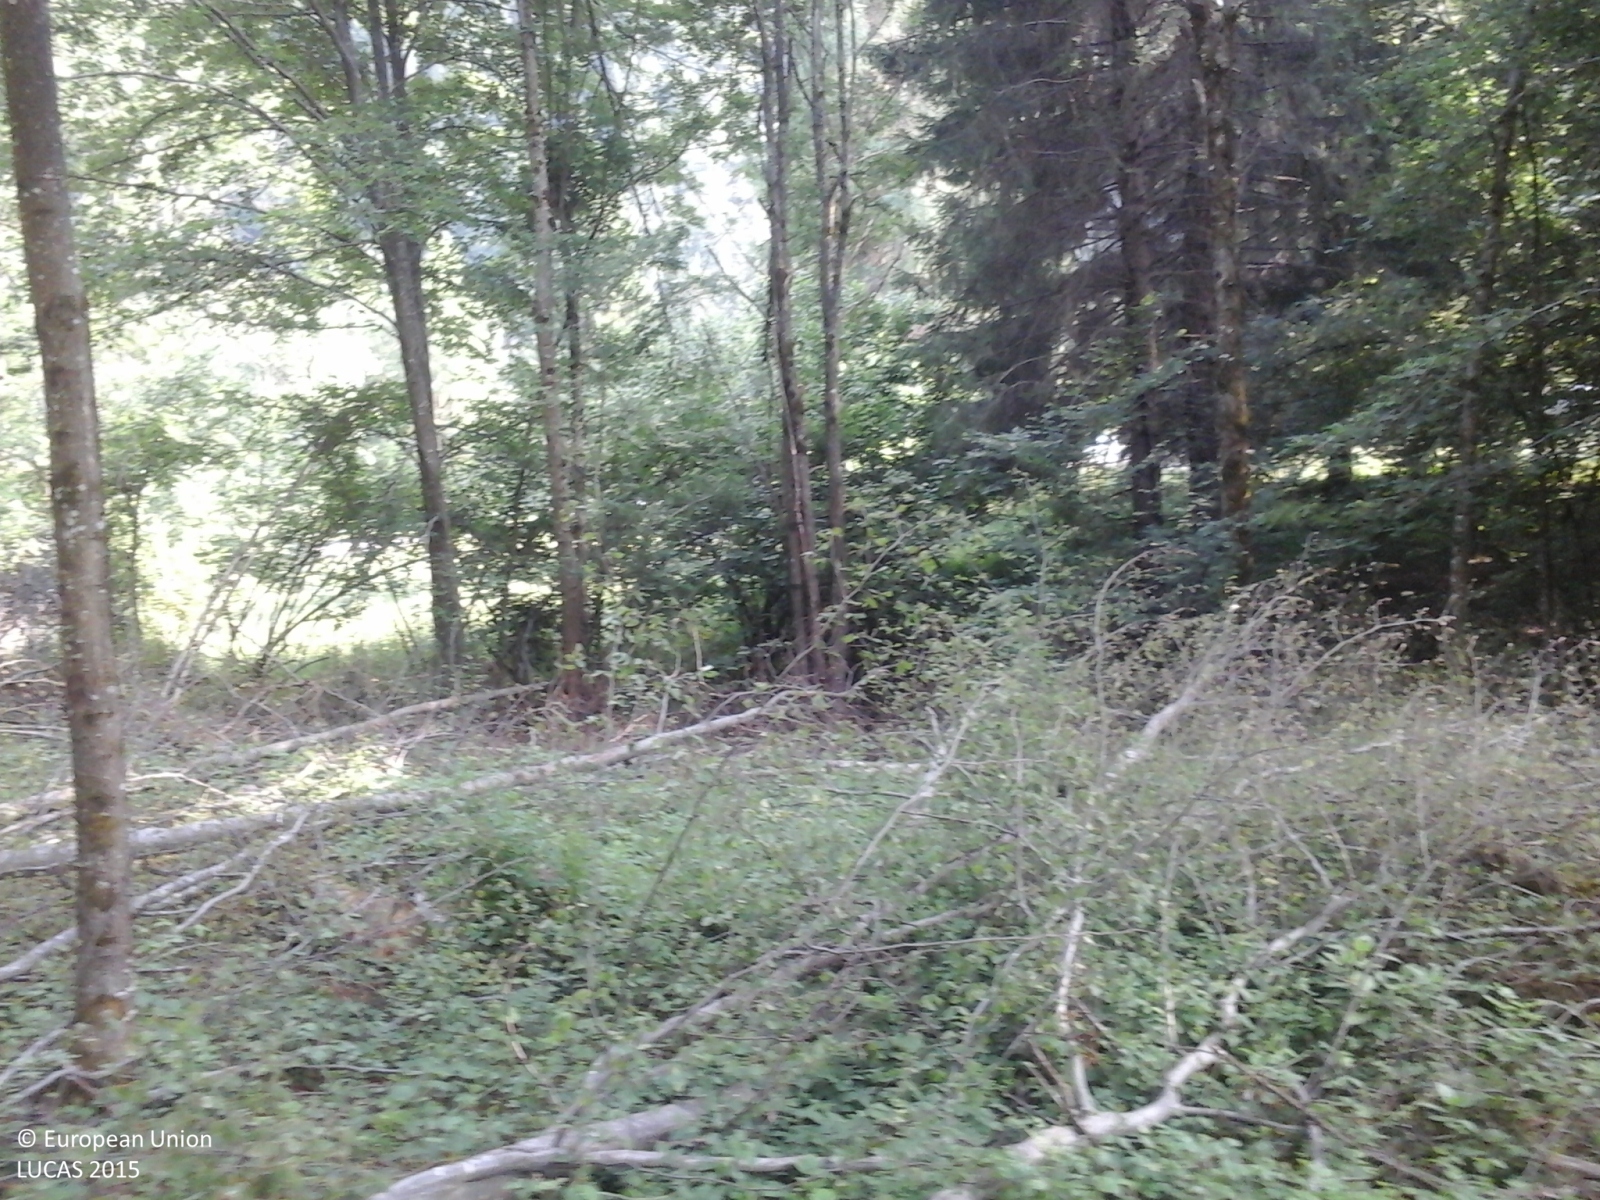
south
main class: Grassland
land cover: Grassland without tree/shrub cover
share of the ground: > 75 %
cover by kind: herbaceous plants 100 %
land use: Agriculture (excluding fallow land and kitchen gardens)
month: June
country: IT
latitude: 46.3468
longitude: 12.1934
